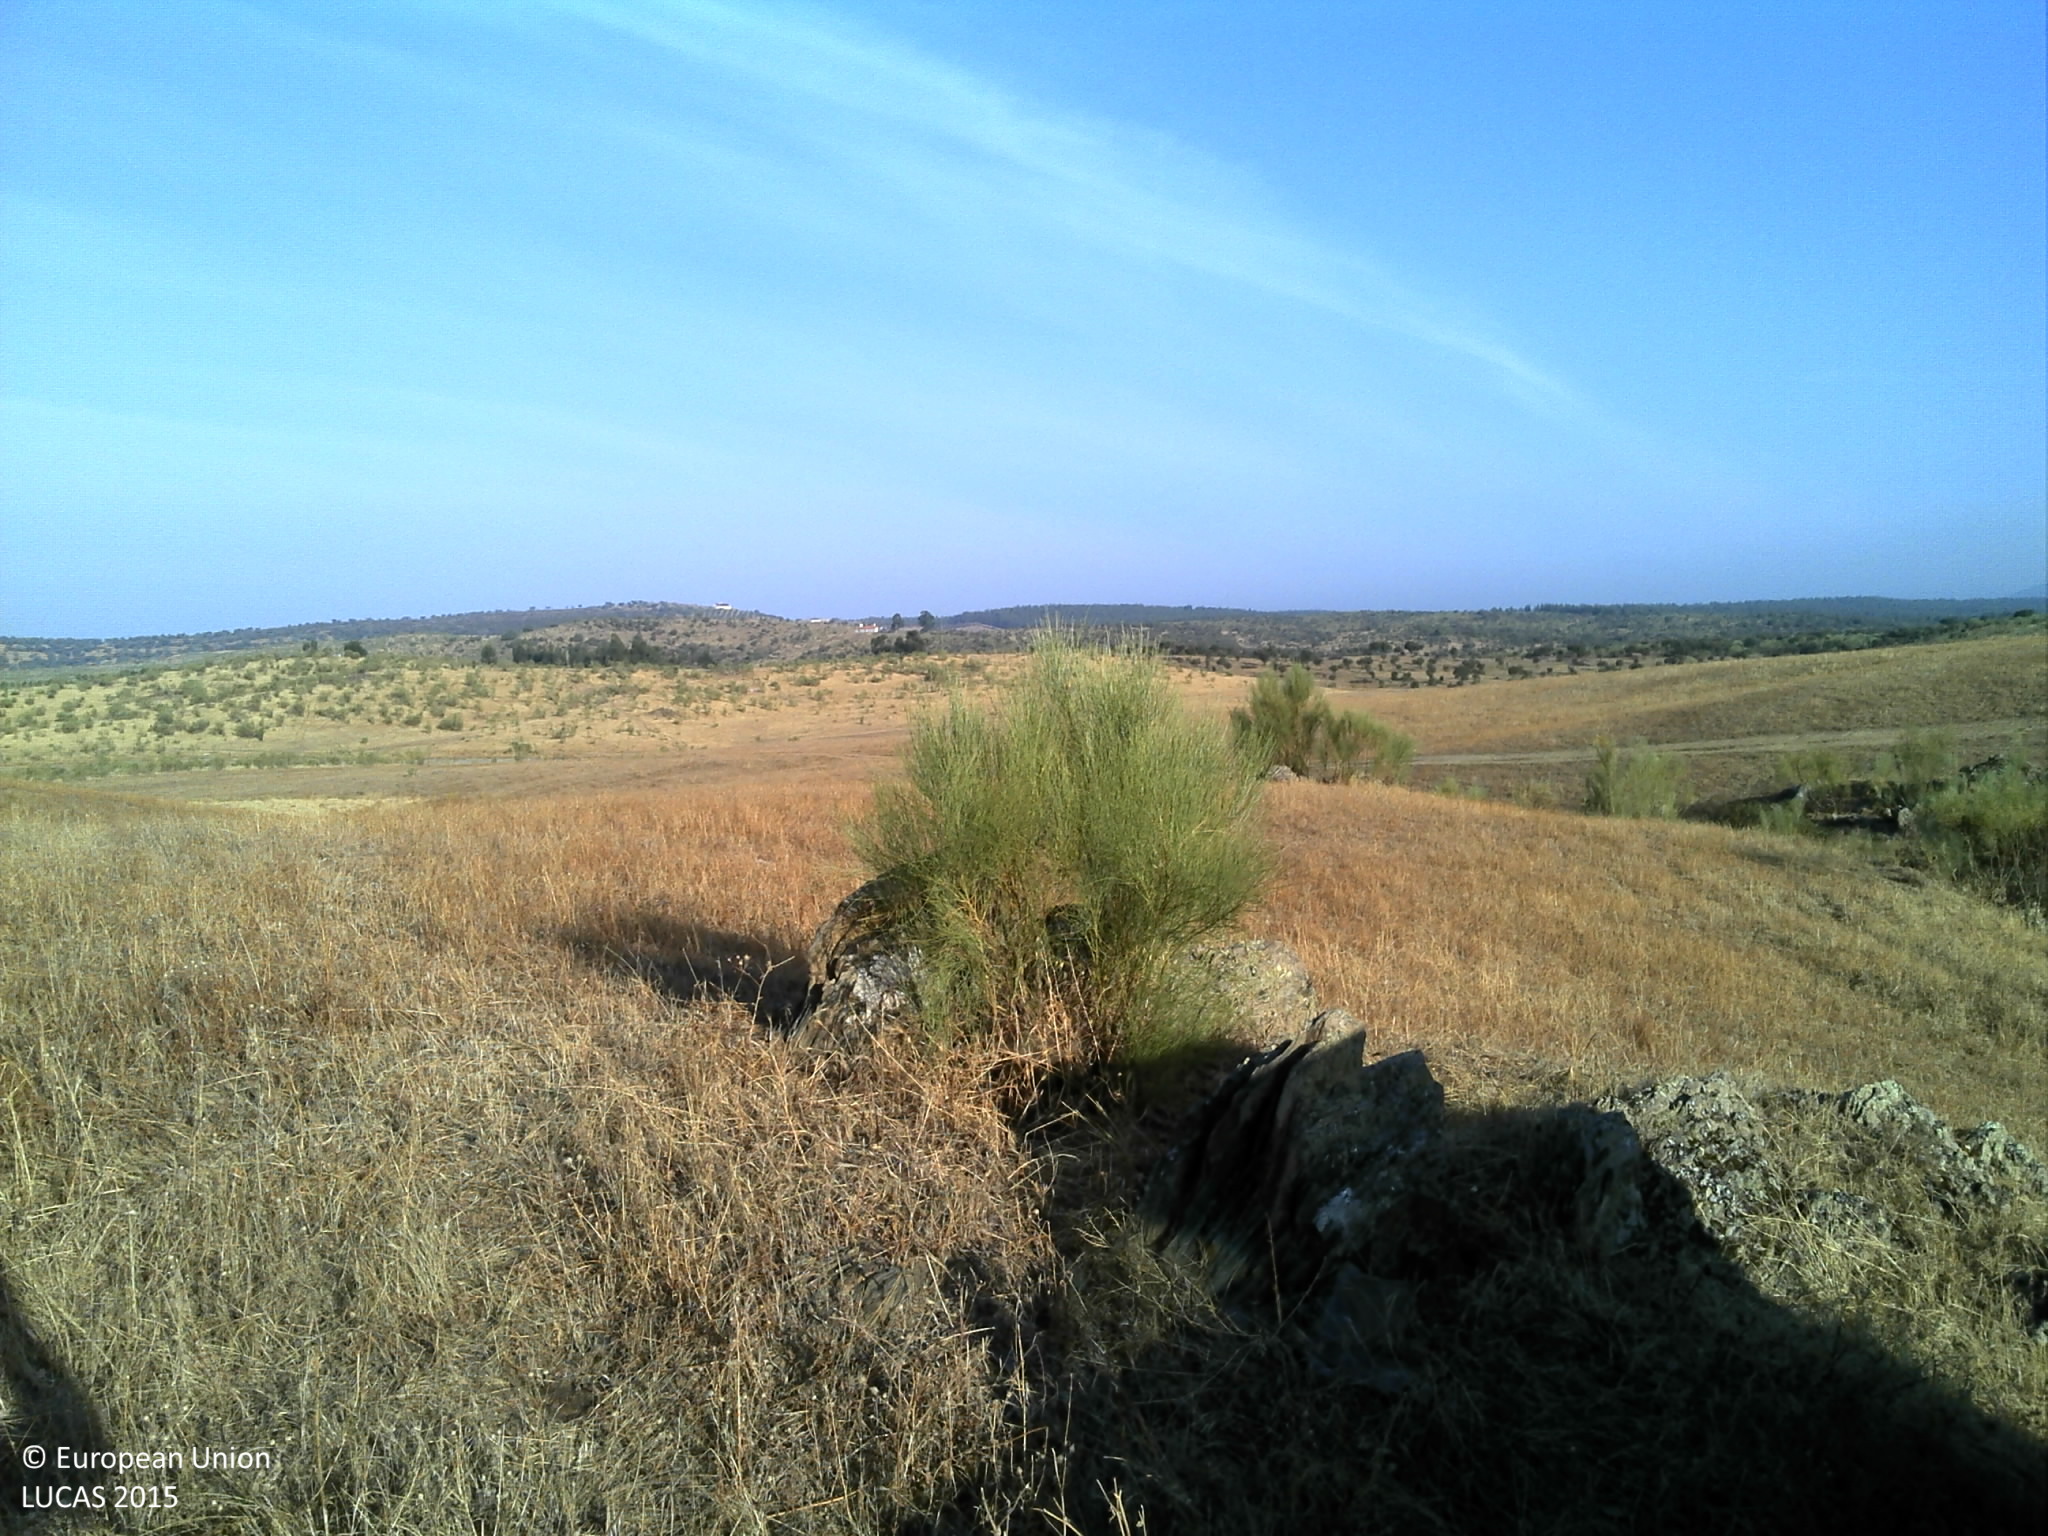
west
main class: Grassland
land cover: Grassland without tree/shrub cover
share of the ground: 50 - 75 %
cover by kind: herbaceous plants 70 %, unconsolidated bare surface 30 %
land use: Agriculture (excluding fallow land and kitchen gardens)
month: July
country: PT
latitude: 38.6414
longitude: -7.4119
